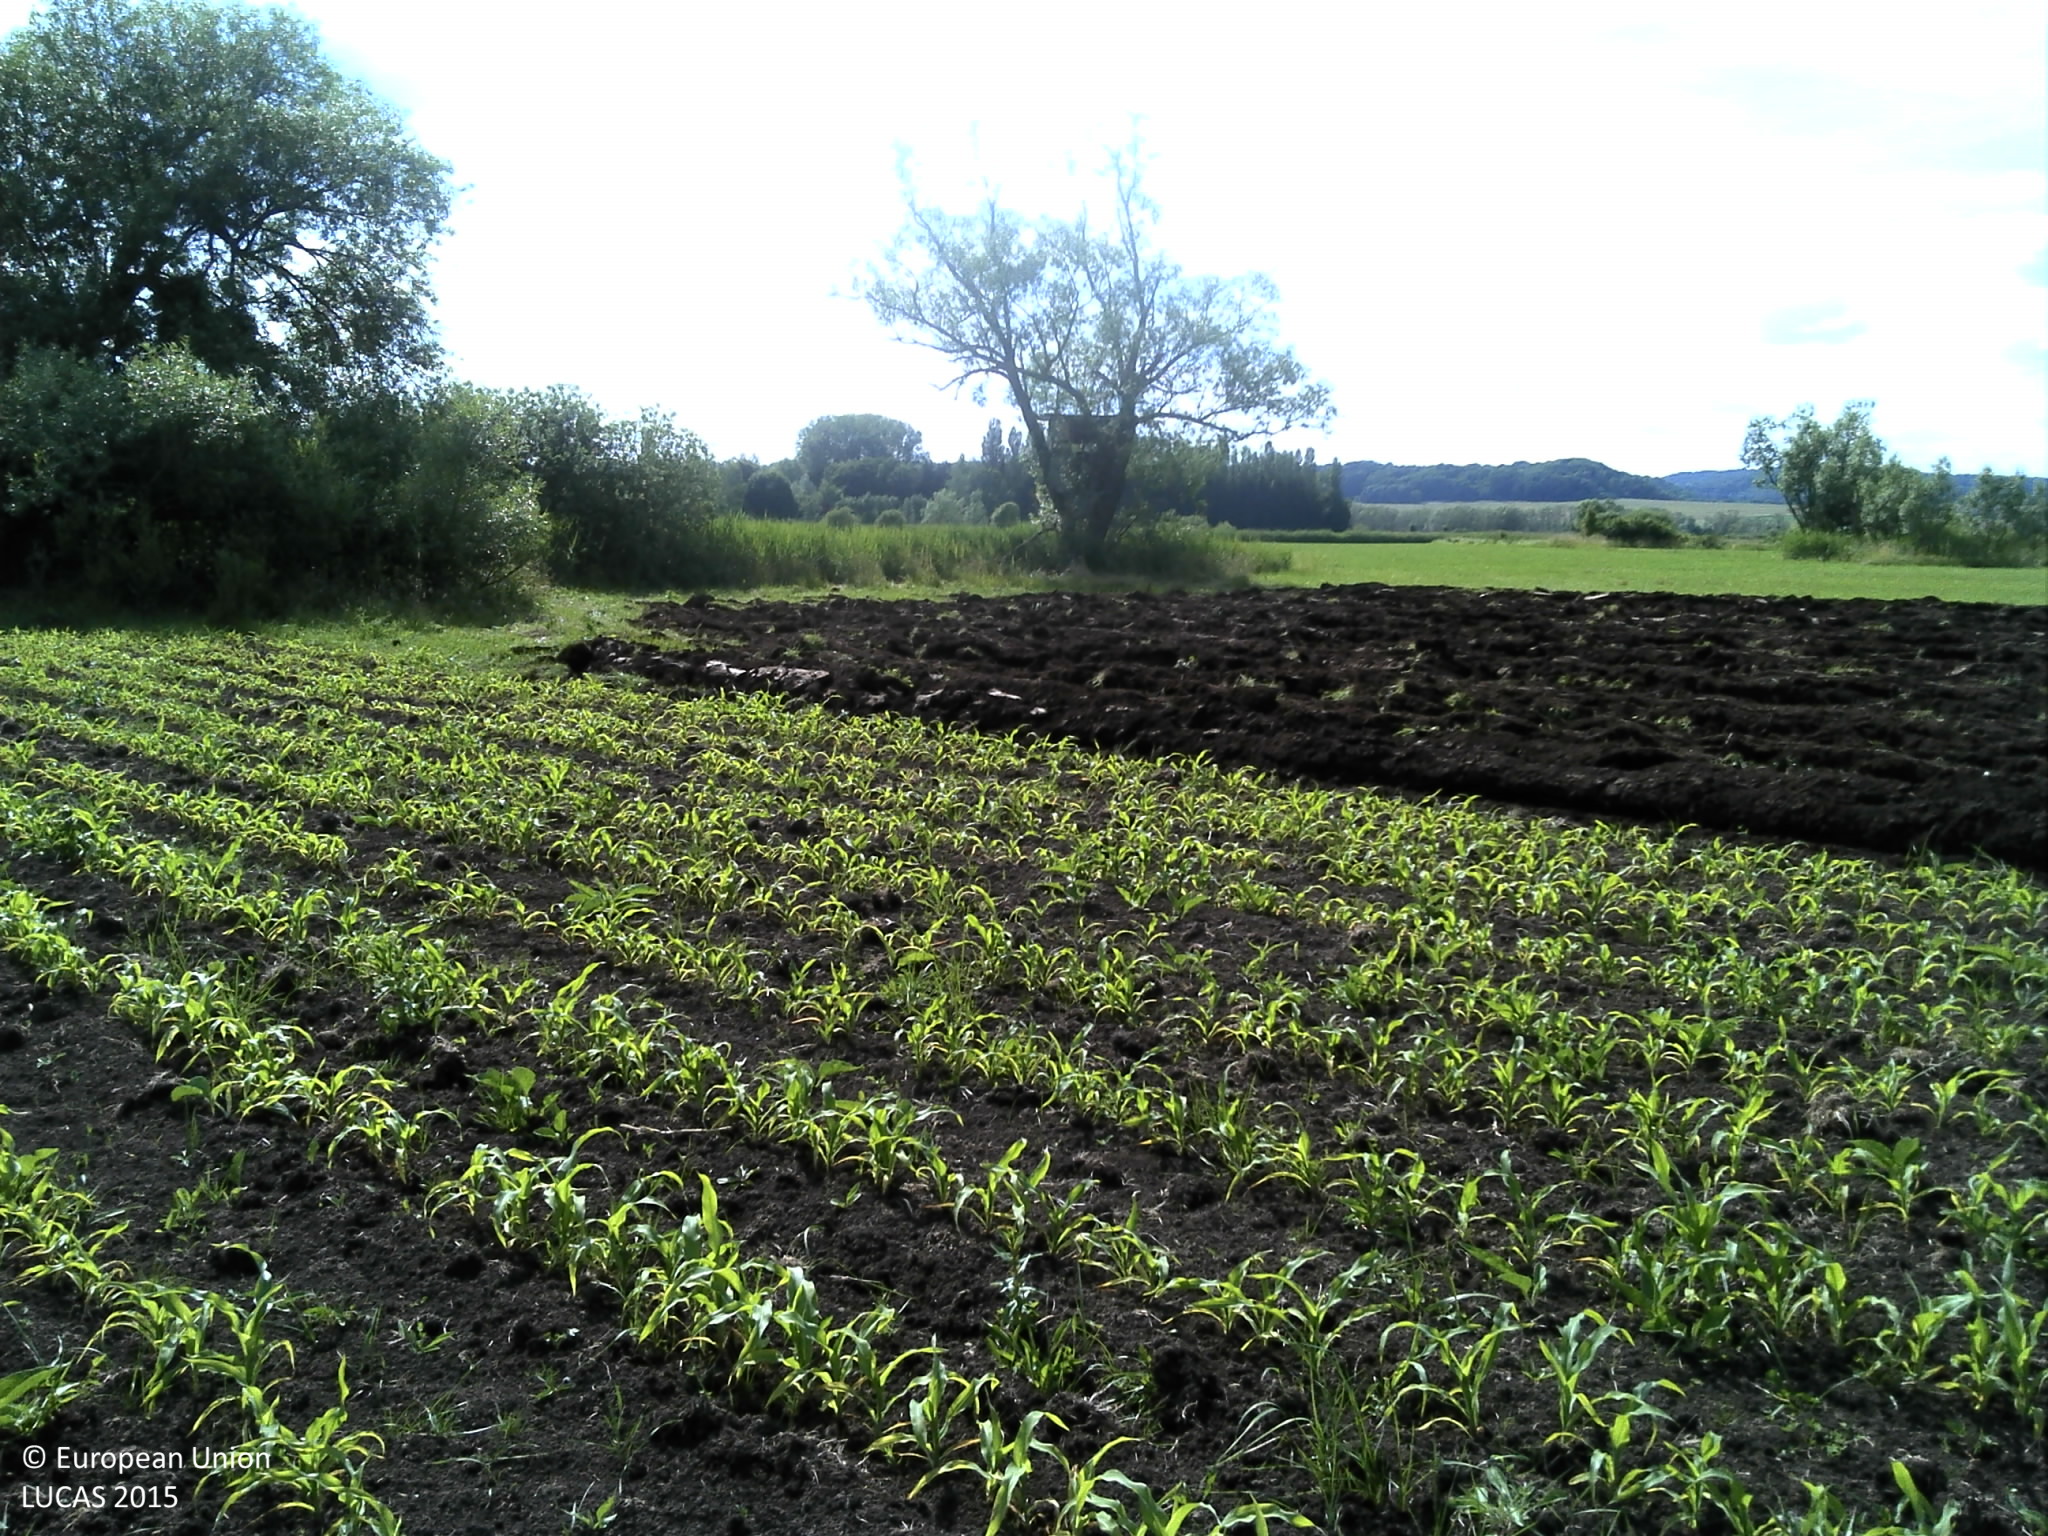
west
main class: Cropland
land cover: Maize
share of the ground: 10 - 25 %
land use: Agriculture (excluding fallow land and kitchen gardens)
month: June
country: FR
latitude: 49.1936
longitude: 6.4733
